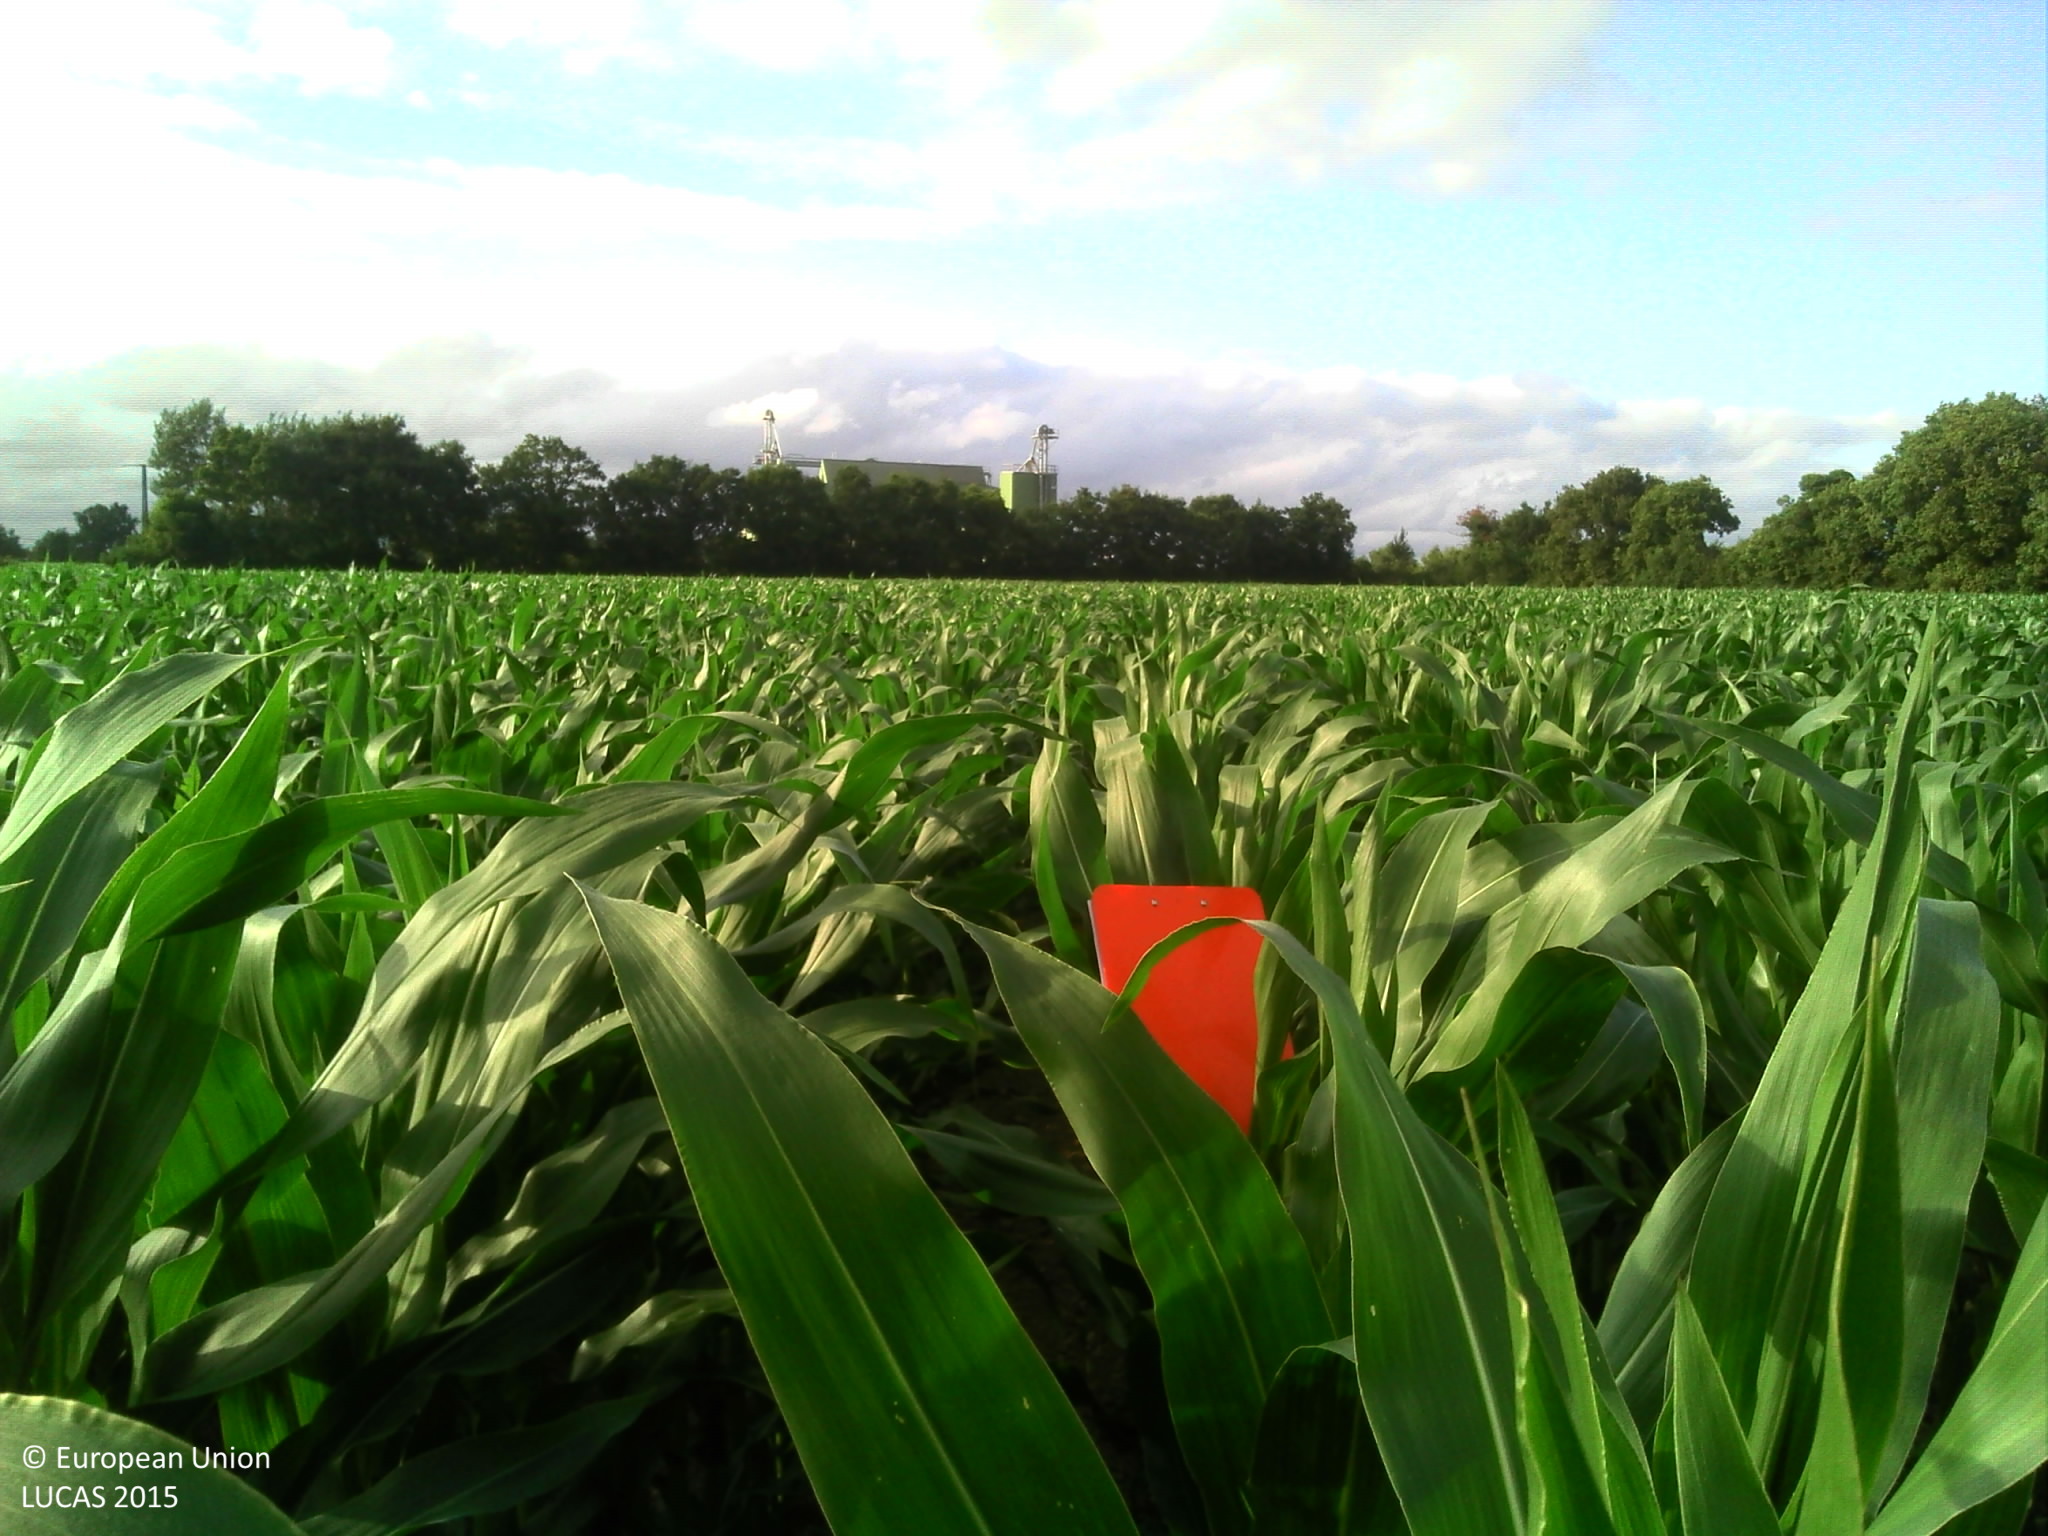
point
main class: Cropland
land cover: Maize
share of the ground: > 75 %
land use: Agriculture (excluding fallow land and kitchen gardens)
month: July
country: FR
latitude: 46.4973
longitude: -1.6227
